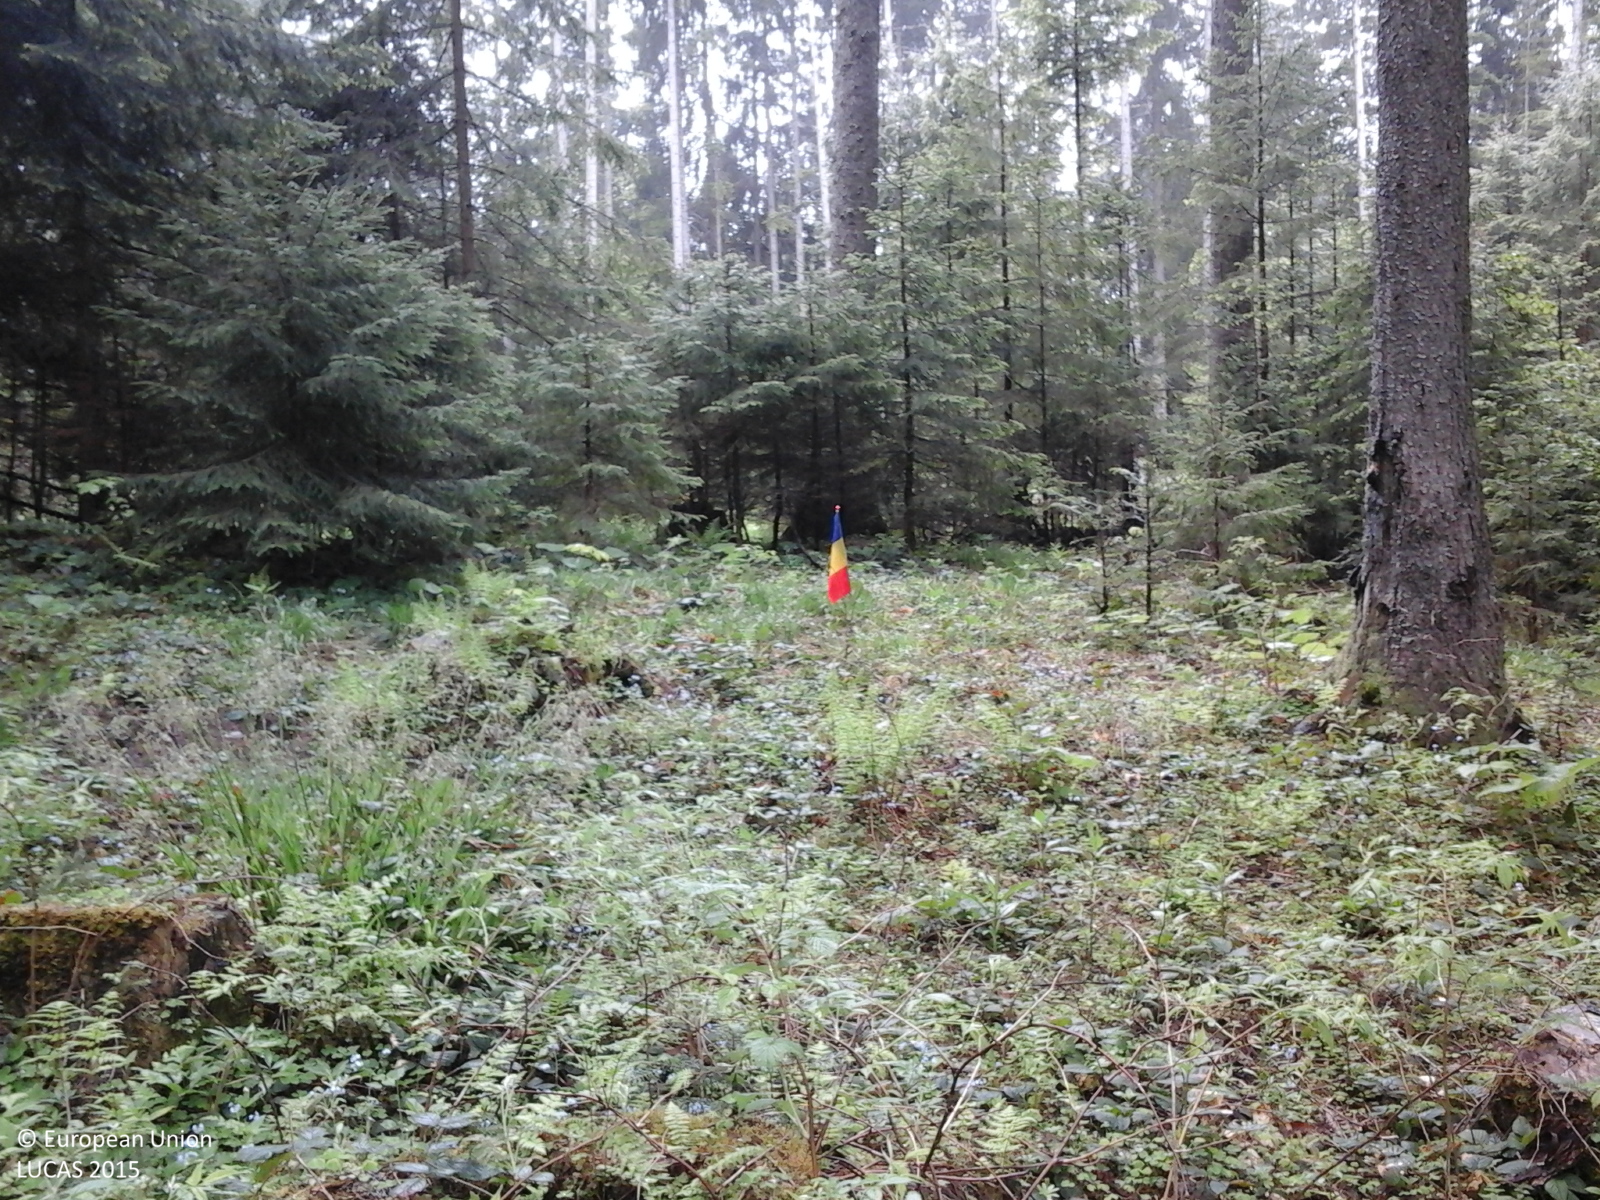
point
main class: Woodland
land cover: Spruce dominated coniferous woodland
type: alpine coniferous forest
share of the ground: > 75 %
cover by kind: coniferous forest trees 90 %, broadleaved forest trees 10 %
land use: Forestry
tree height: > 5 m
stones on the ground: < 10 %
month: May
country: RO
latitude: 45.4875
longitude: 25.6238
